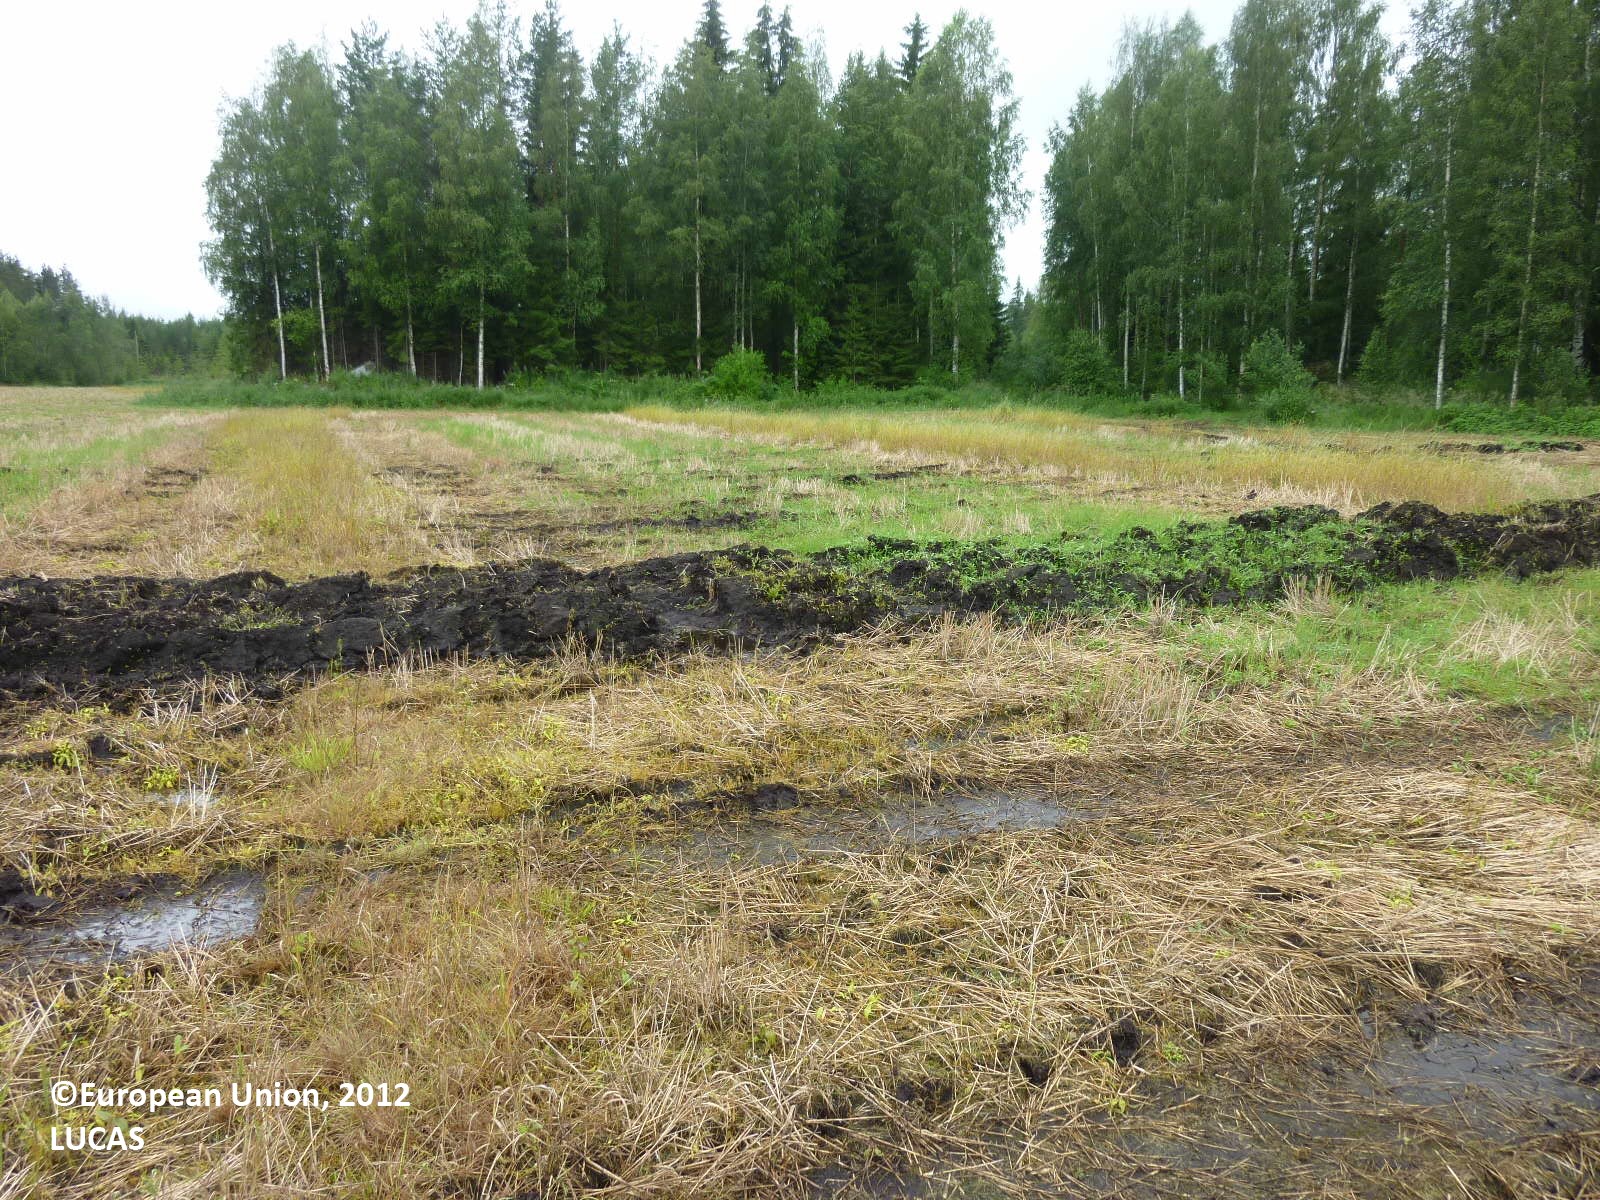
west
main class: Cropland
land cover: Oats
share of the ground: > 75 %
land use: Agriculture (excluding fallow land and kitchen gardens)
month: July
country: FI
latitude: 61.4651
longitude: 22.7340
